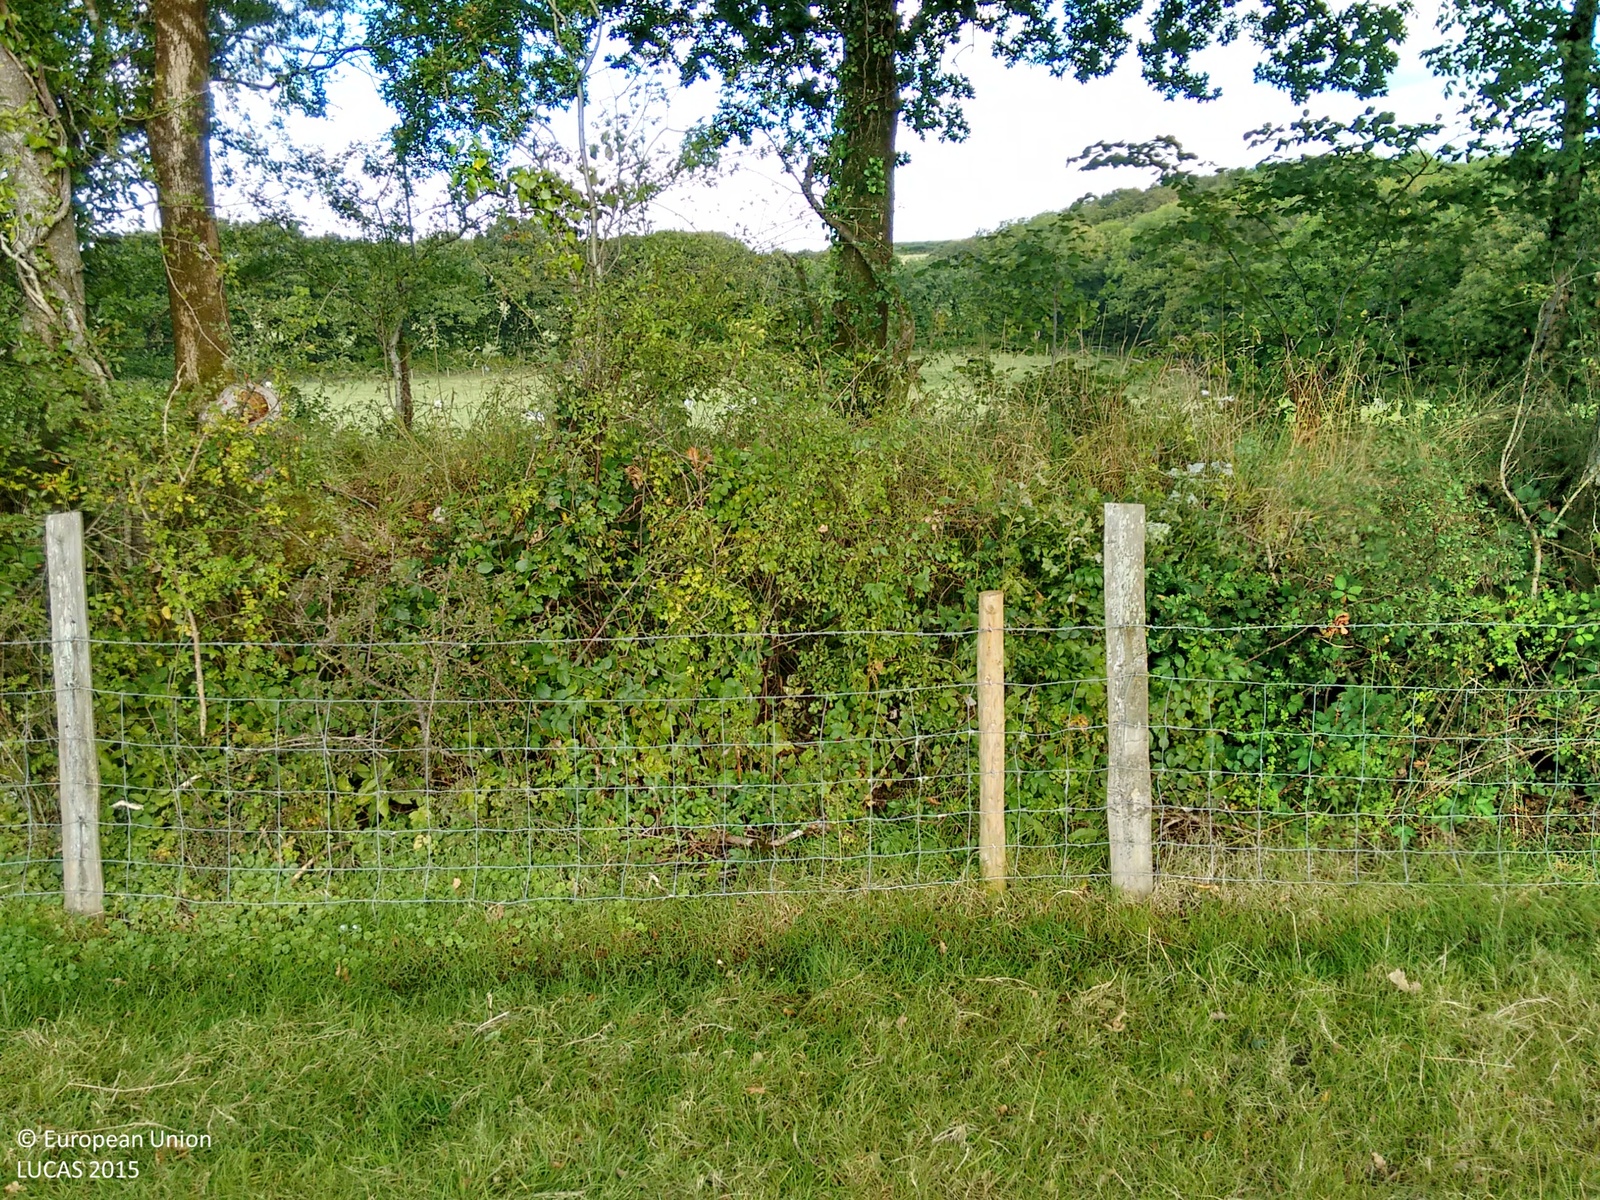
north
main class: Grassland
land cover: Grassland without tree/shrub cover
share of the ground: > 75 %
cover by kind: herbaceous plants 100 %
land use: Agriculture (excluding fallow land and kitchen gardens)
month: September
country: GB
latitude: 50.8383
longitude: -4.0831
